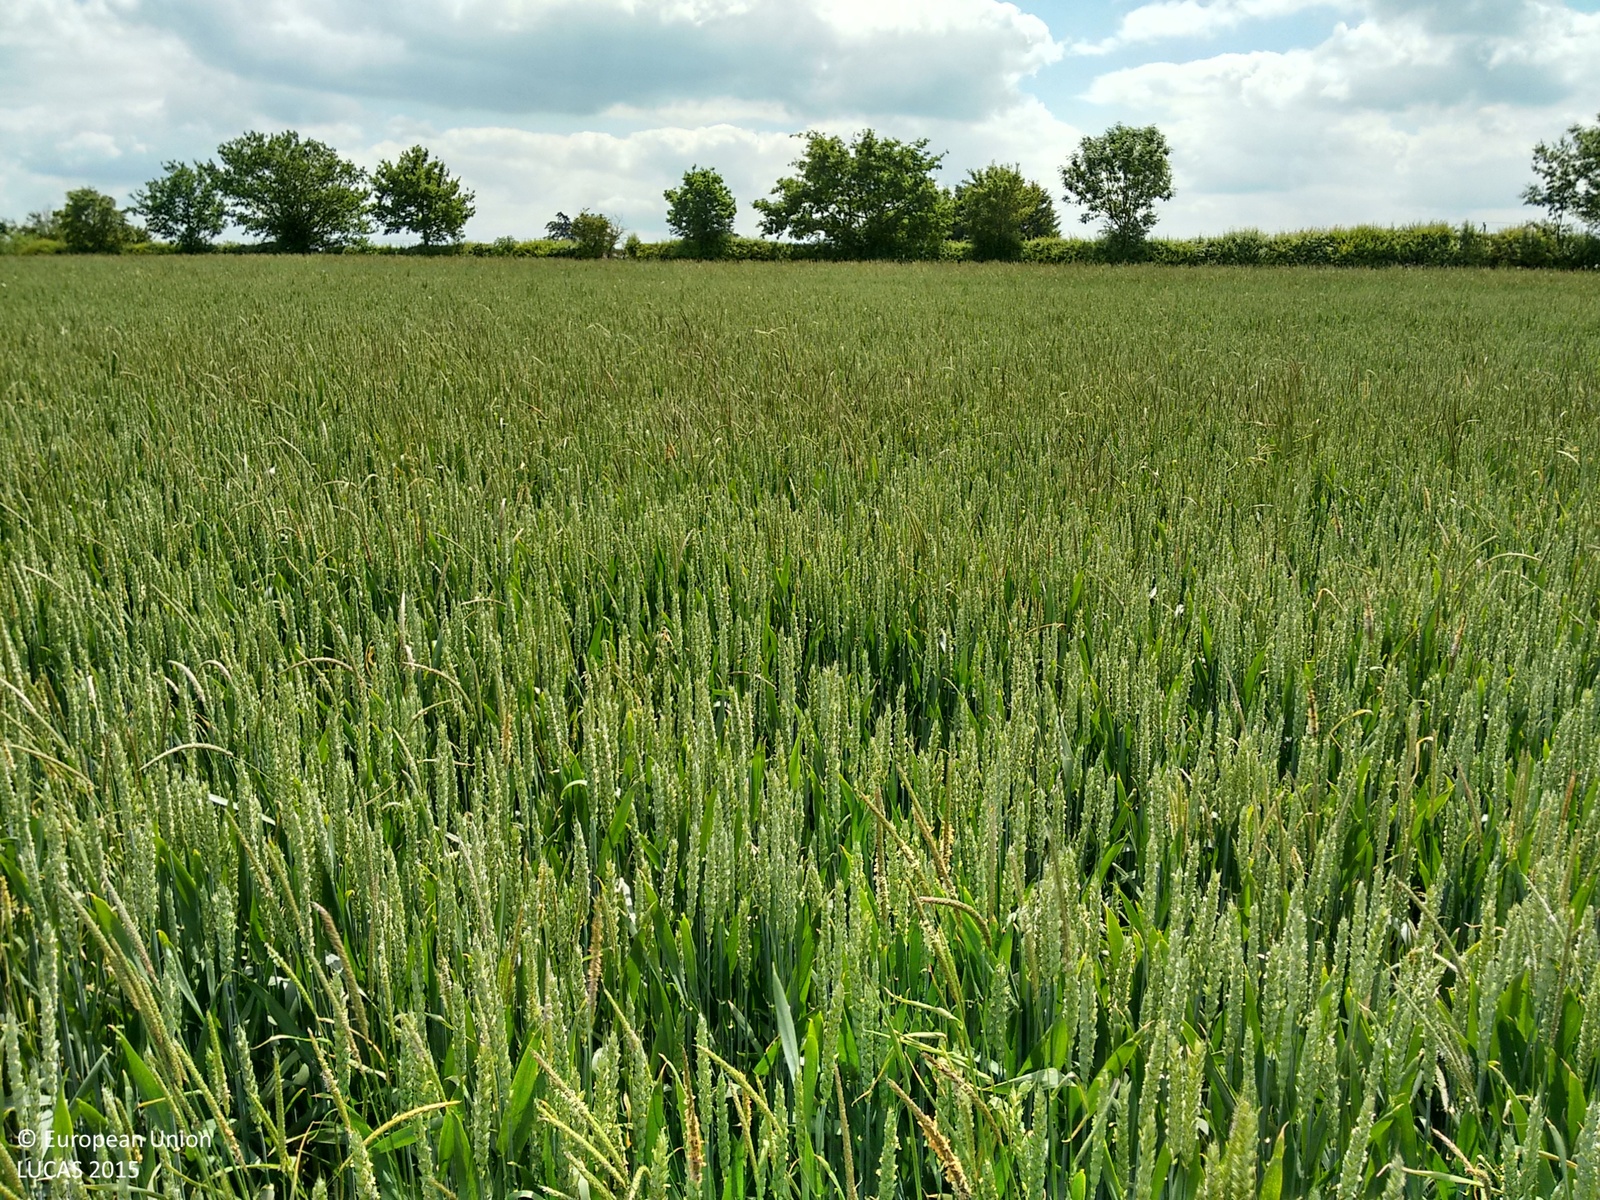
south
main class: Cropland
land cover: Common wheat
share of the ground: > 75 %
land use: Agriculture (excluding fallow land and kitchen gardens)
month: June
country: GB
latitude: 52.0759
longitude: -0.6769
